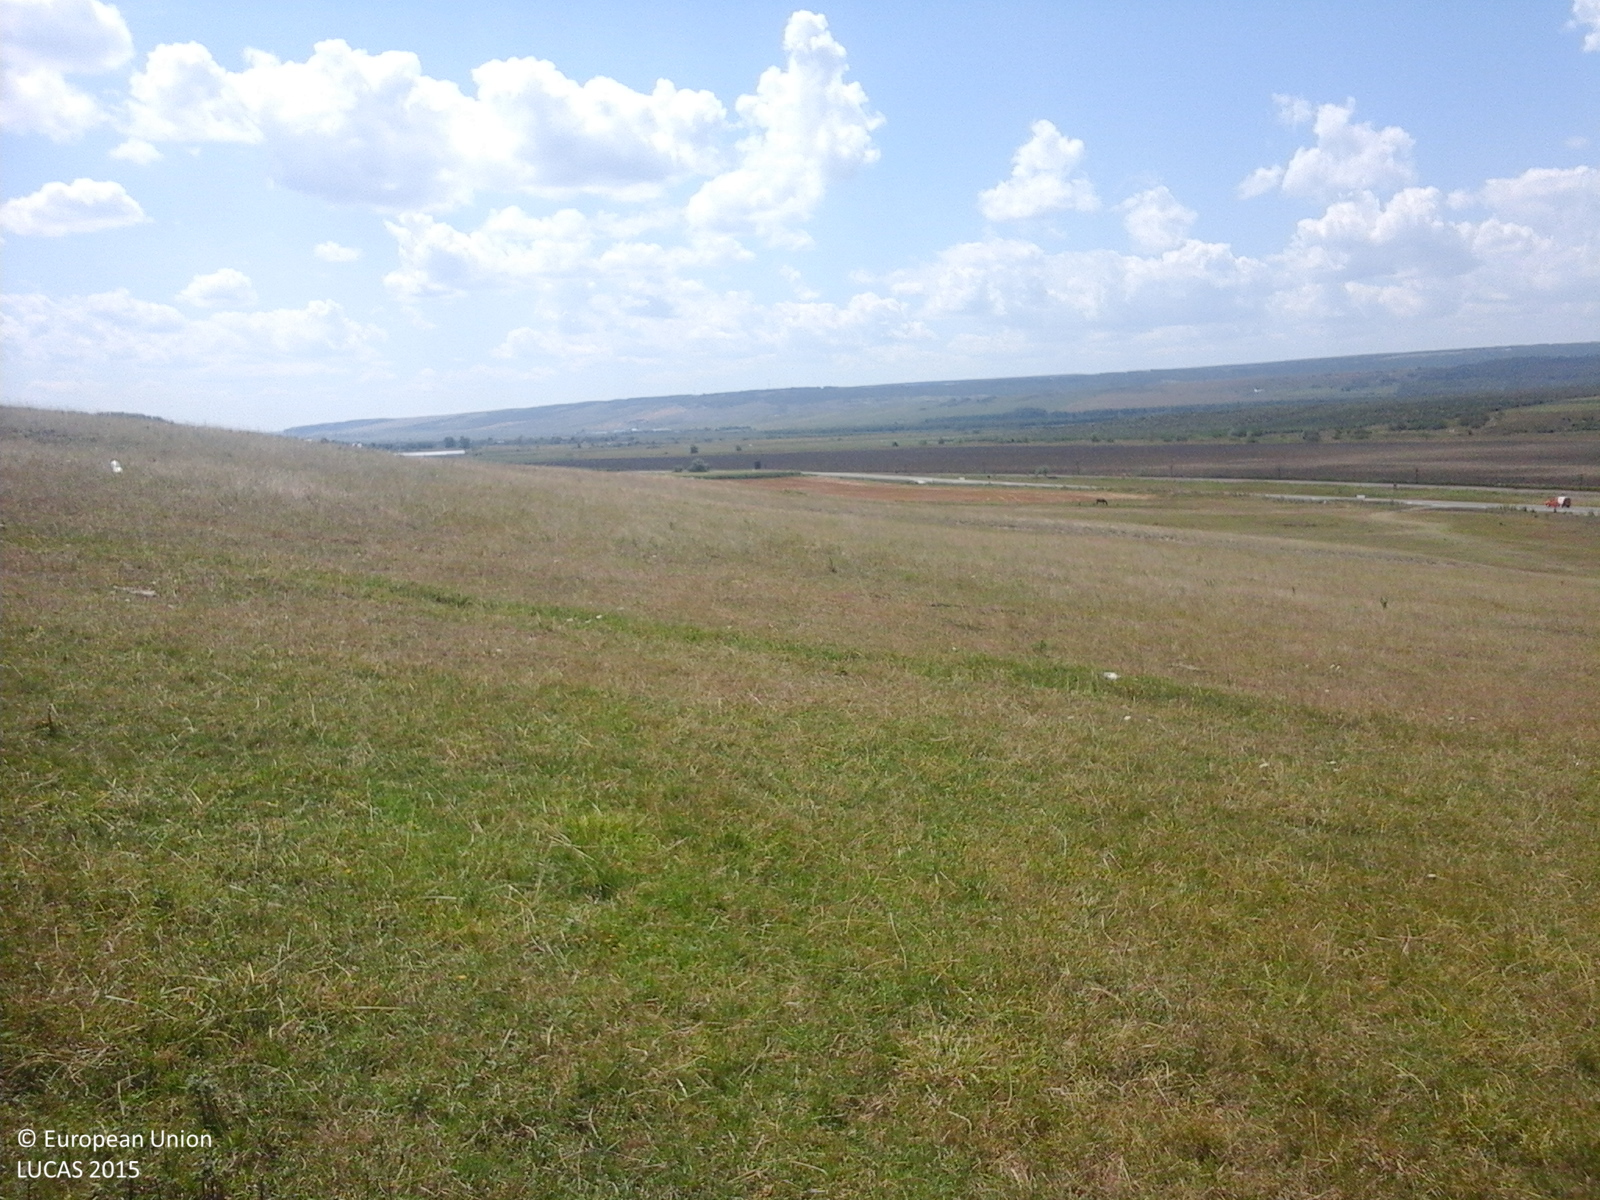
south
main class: Grassland
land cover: Grassland without tree/shrub cover
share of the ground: > 75 %
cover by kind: herbaceous plants 100 %
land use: Agriculture (excluding fallow land and kitchen gardens)
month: July
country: RO
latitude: 46.5312
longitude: 27.8398
